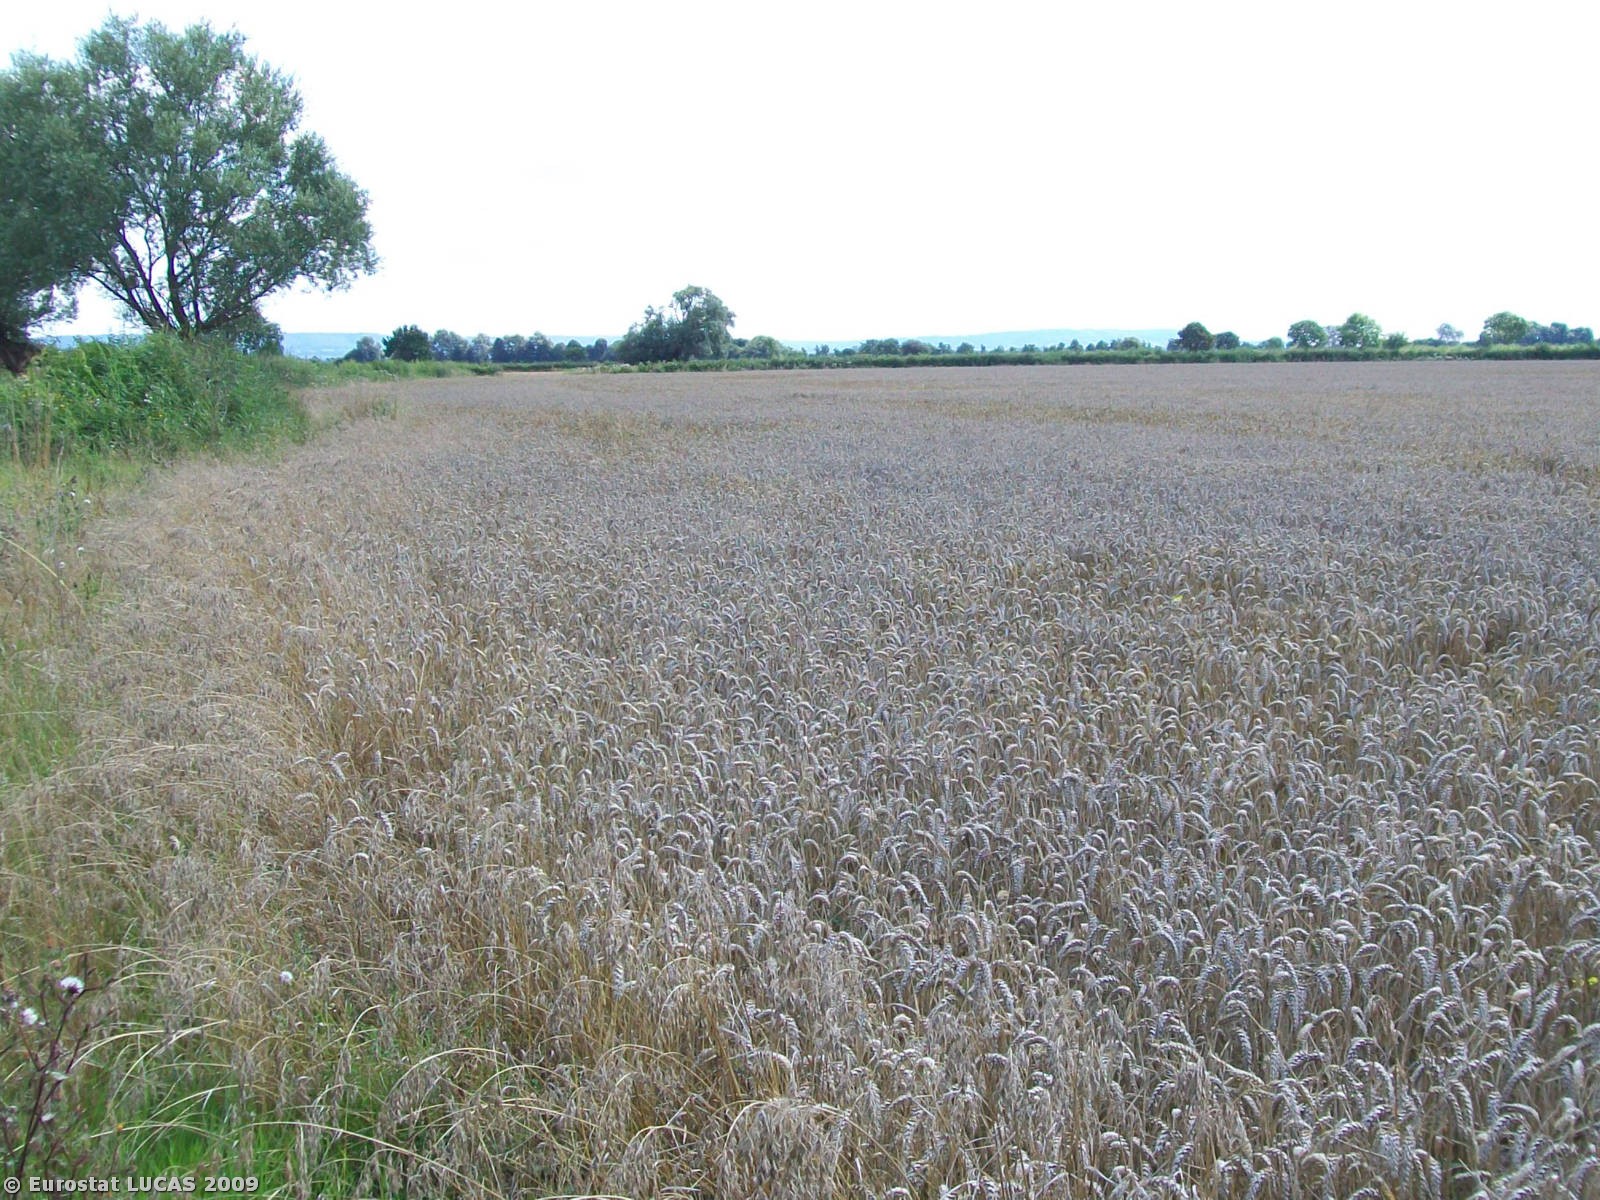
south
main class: Cropland
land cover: Common wheat
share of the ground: > 75 %
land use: Agriculture (excluding fallow land and kitchen gardens)
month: August
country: GB
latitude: 51.8203
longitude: -2.3520
